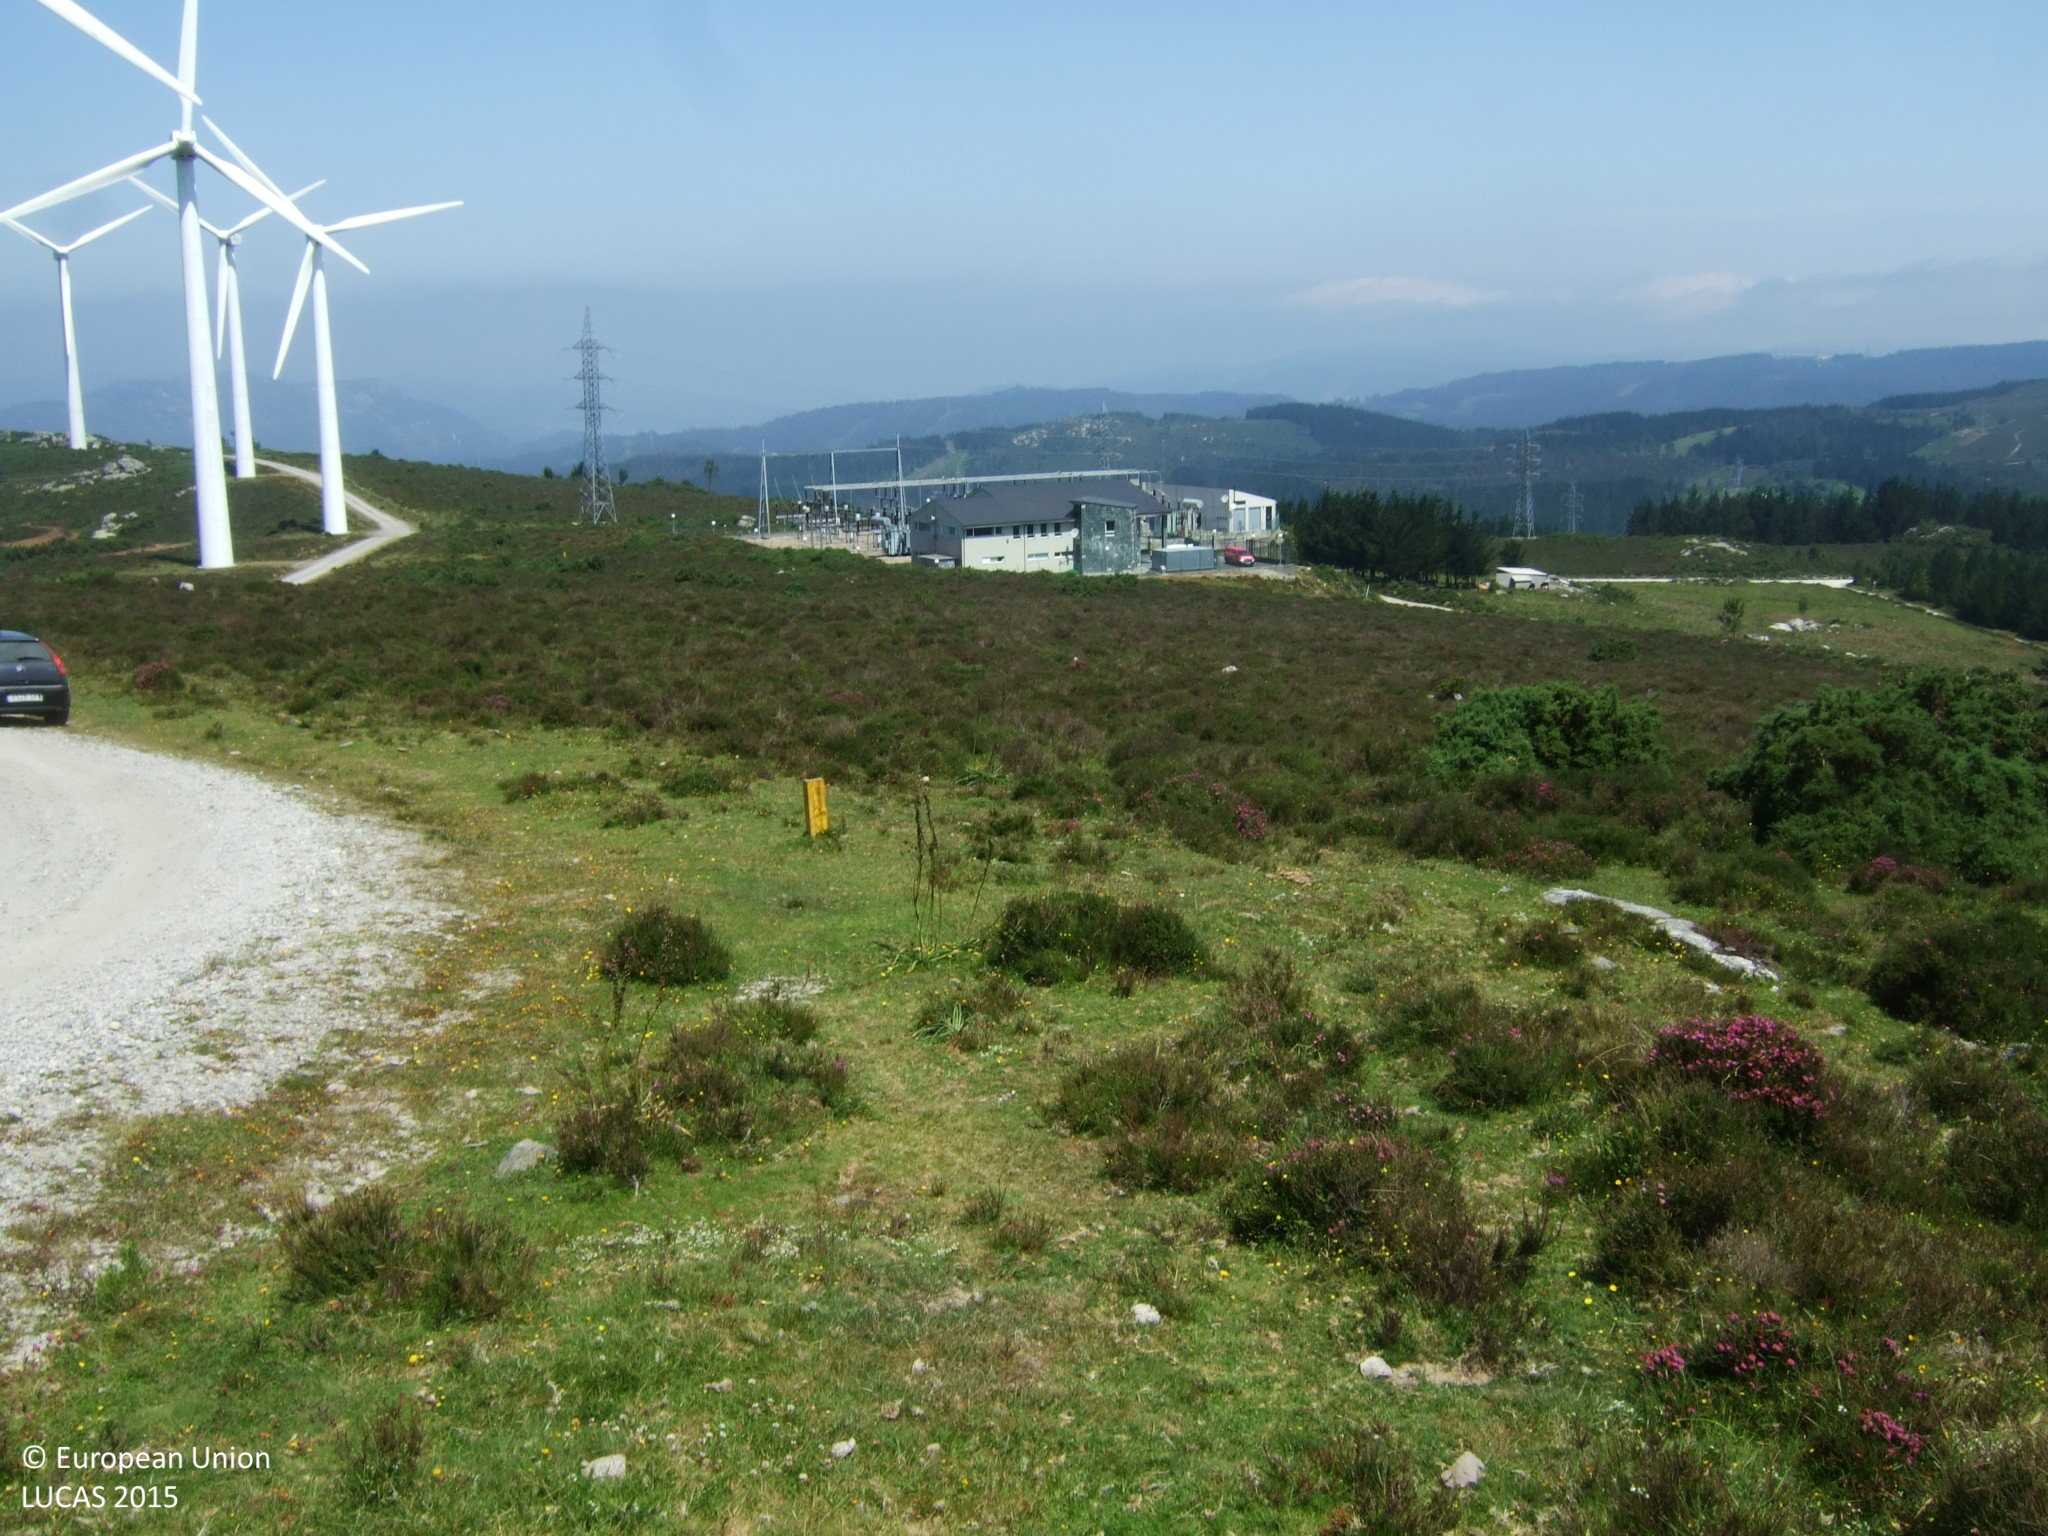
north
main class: Grassland
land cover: Grassland without tree/shrub cover
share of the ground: > 75 %
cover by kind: herbaceous plants 95 %, shrubs 5 %
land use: Agriculture (excluding fallow land and kitchen gardens)
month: June
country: ES
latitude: 43.5372
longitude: -7.5700
